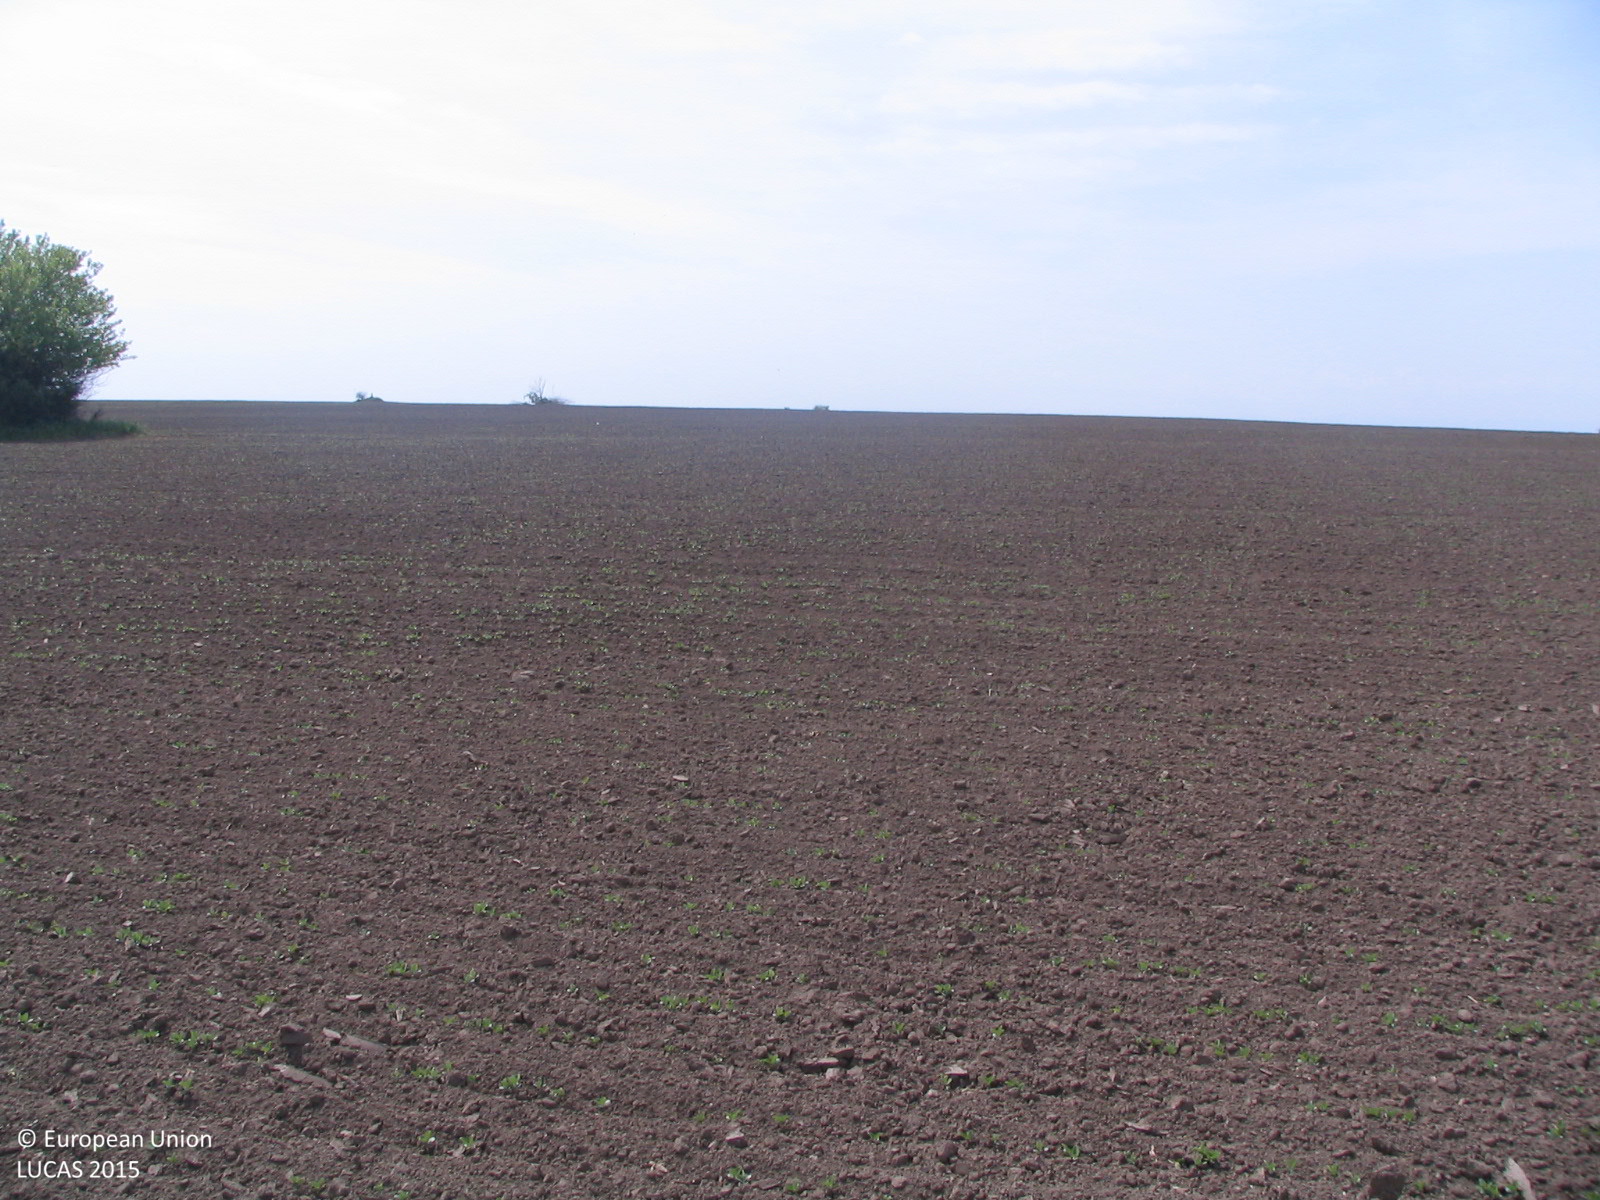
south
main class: Cropland
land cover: Soya
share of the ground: < 10 %
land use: Agriculture (excluding fallow land and kitchen gardens)
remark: Tilled/Sowed
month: May
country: BG
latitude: 43.6651
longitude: 23.9050
